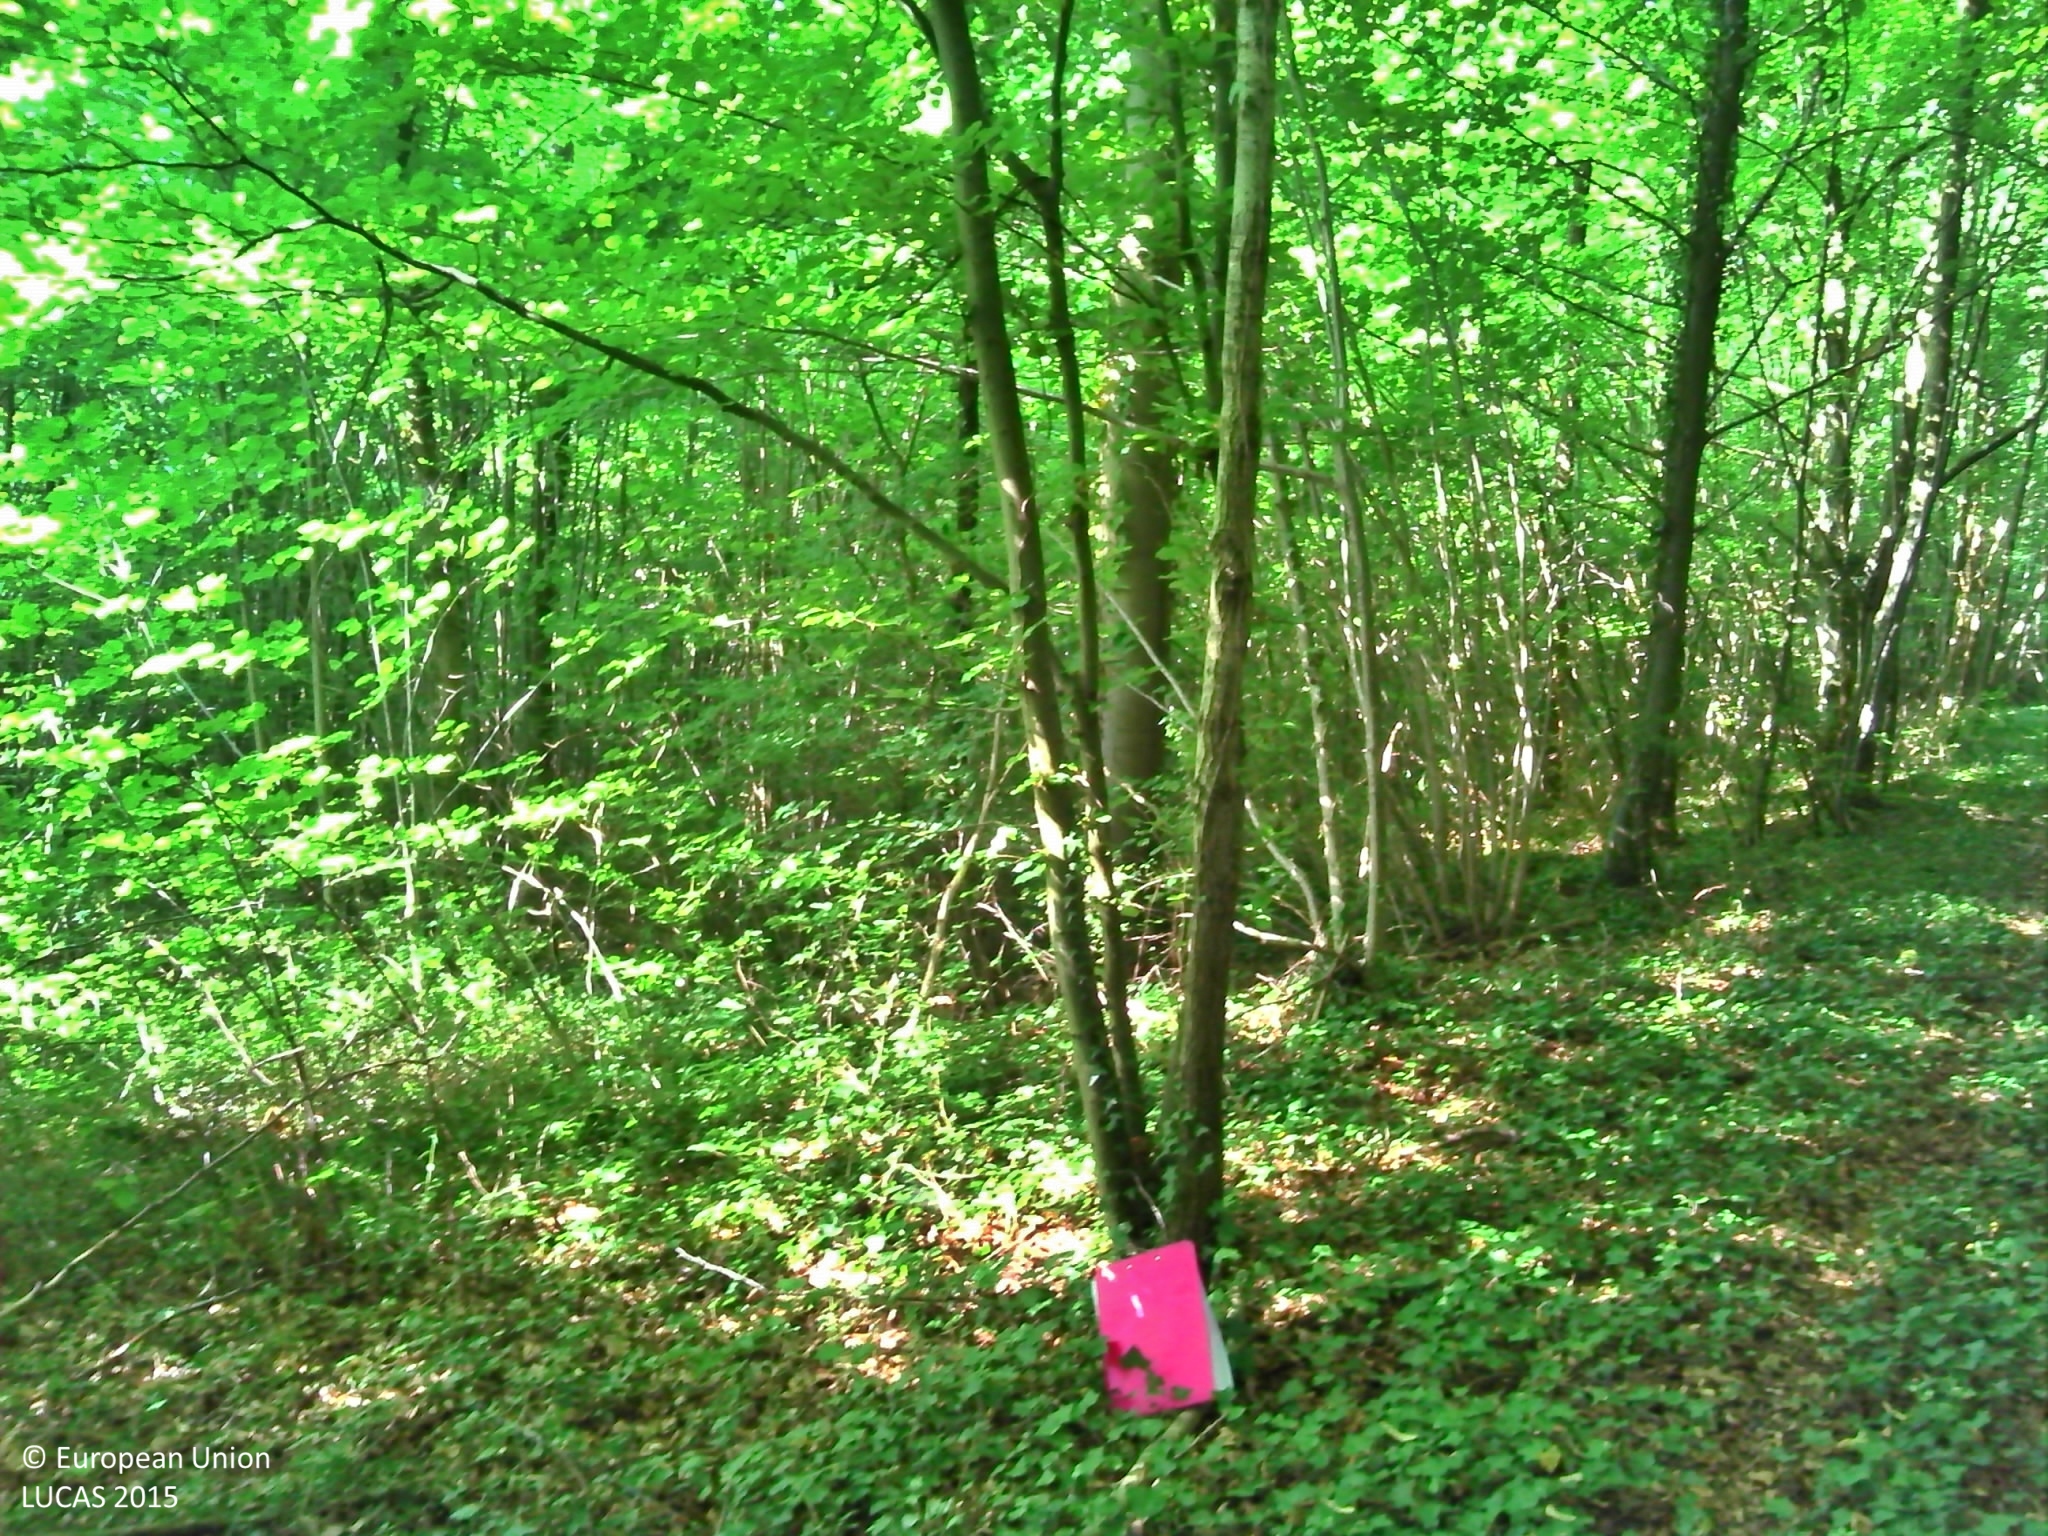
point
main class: Woodland
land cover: Broadleaved woodland
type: beech forest
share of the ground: > 75 %
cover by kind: broadleaved forest trees 70 %, shrubs 15 %, herbaceous plants 15 %
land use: Forestry
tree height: > 5 m
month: July
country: FR
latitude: 49.2951
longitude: 2.3559
